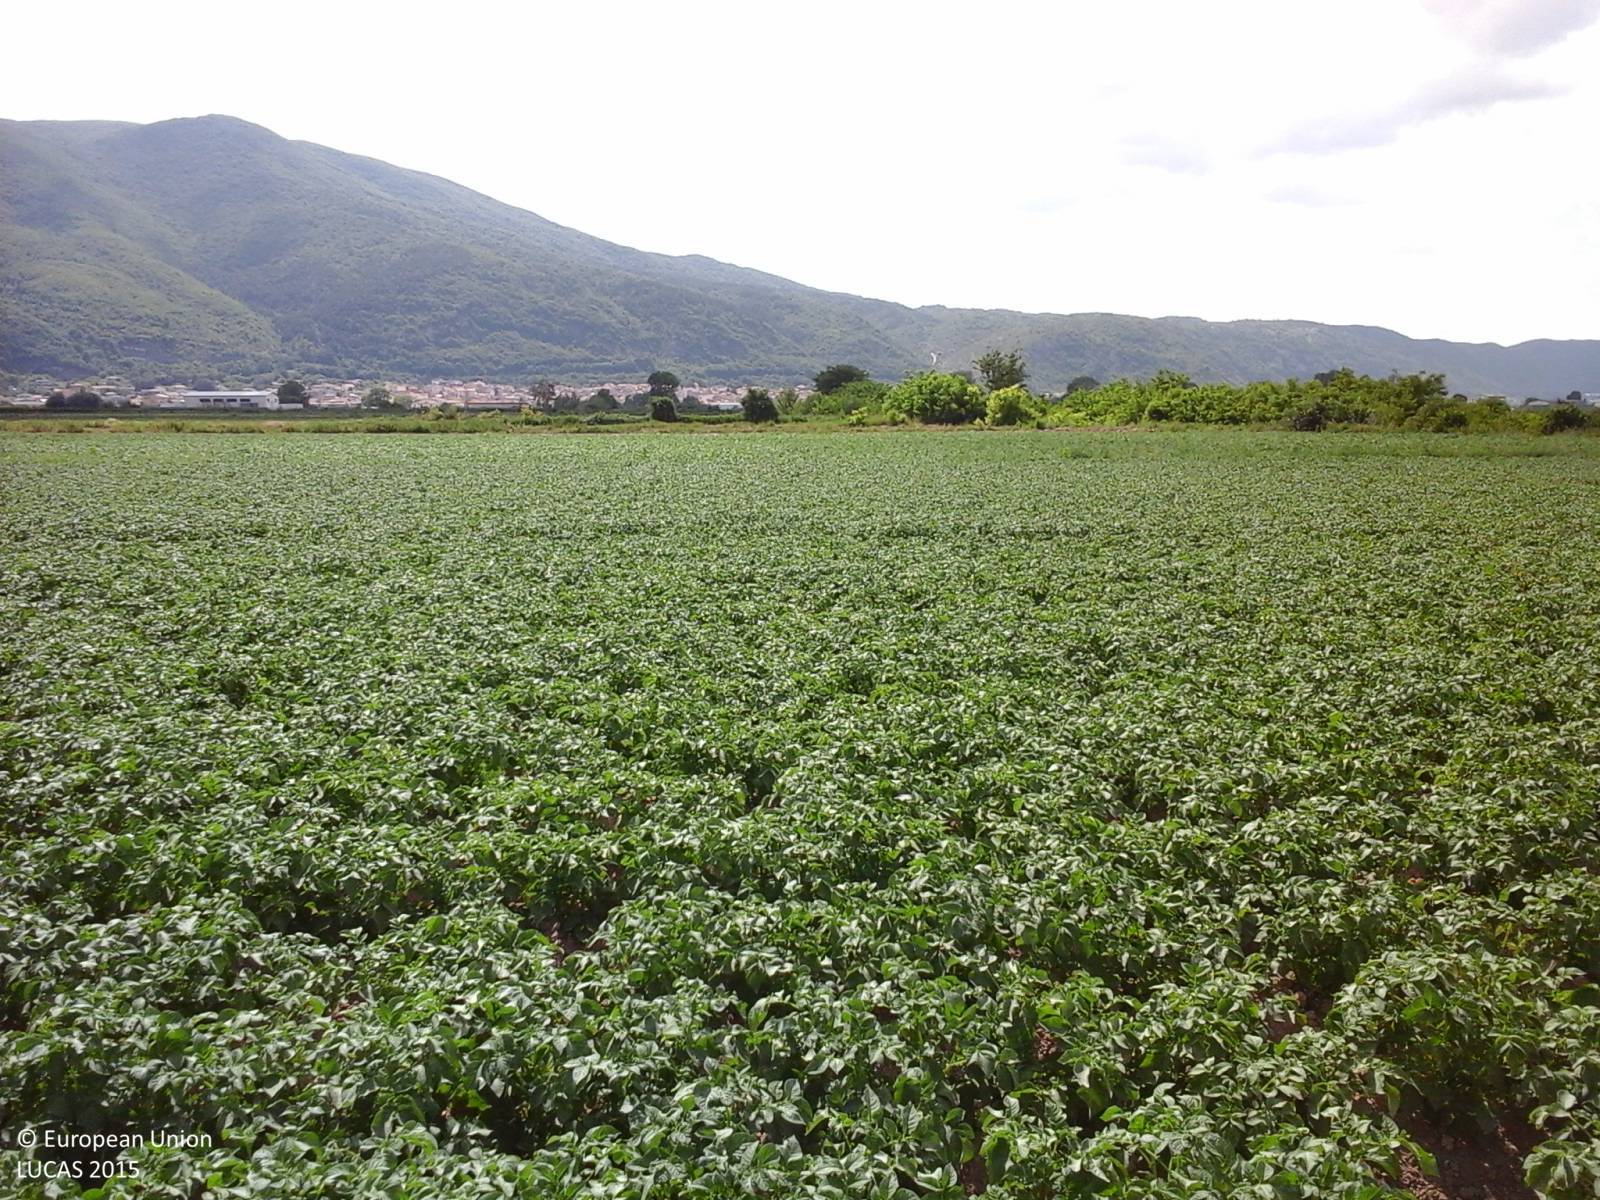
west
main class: Cropland
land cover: Potatoes
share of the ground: > 75 %
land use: Agriculture (excluding fallow land and kitchen gardens)
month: June
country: IT
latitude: 41.9608
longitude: 13.4988
